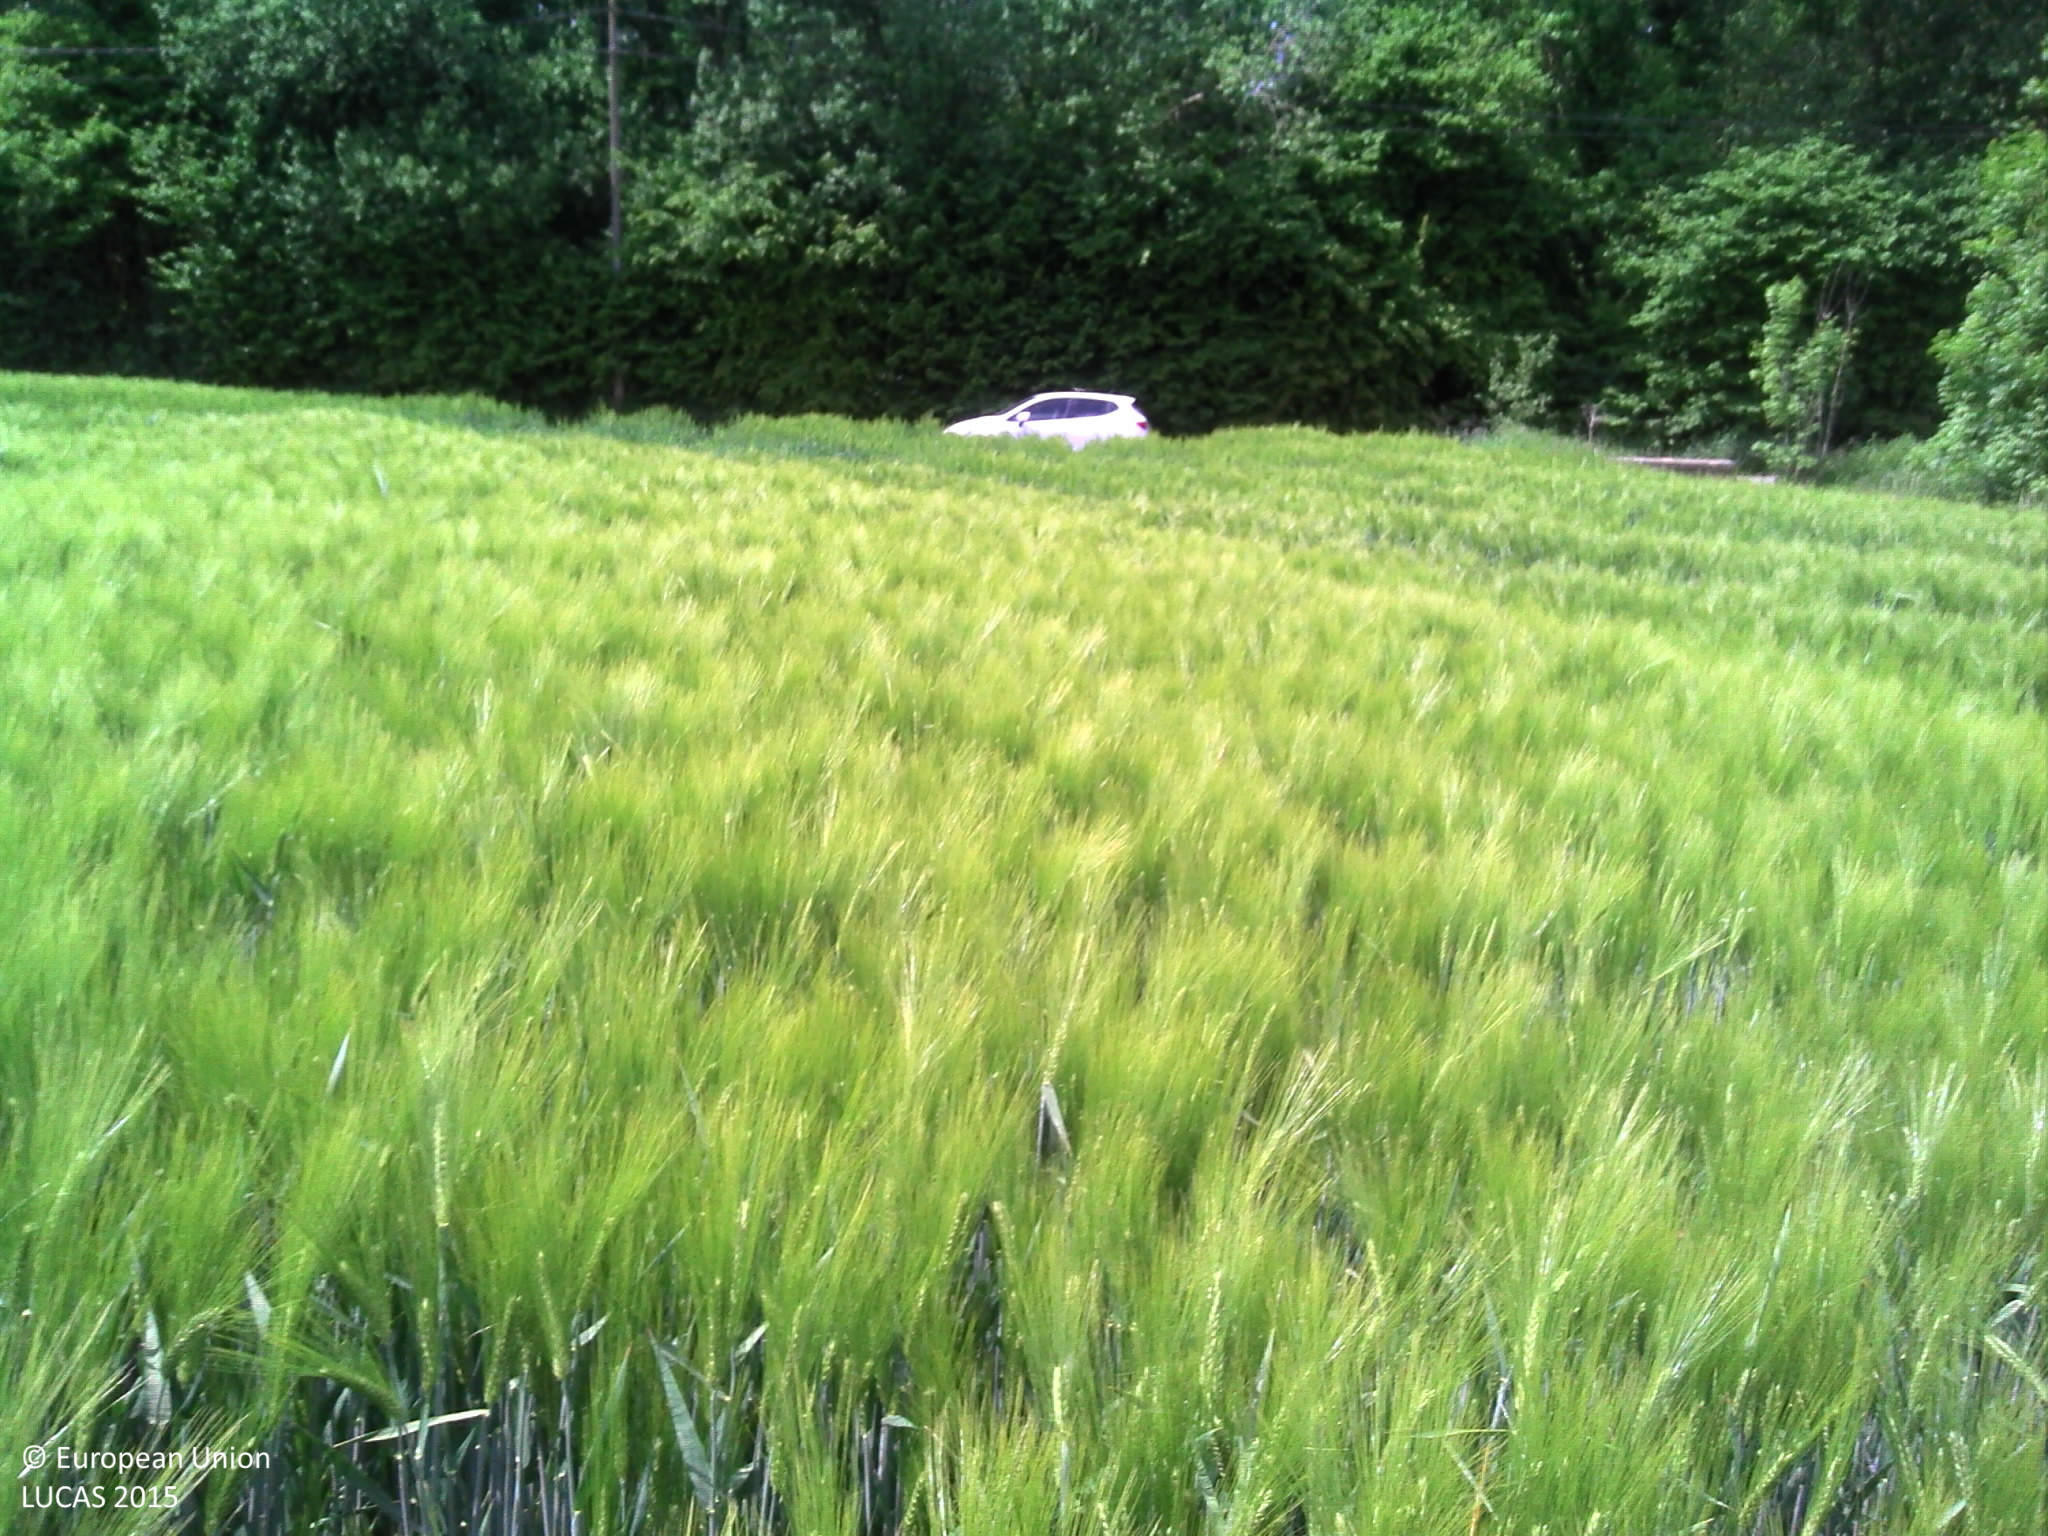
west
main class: Cropland
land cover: Barley
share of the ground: > 75 %
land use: Agriculture (excluding fallow land and kitchen gardens)
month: May
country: BE
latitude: 50.5909
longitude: 4.4726
